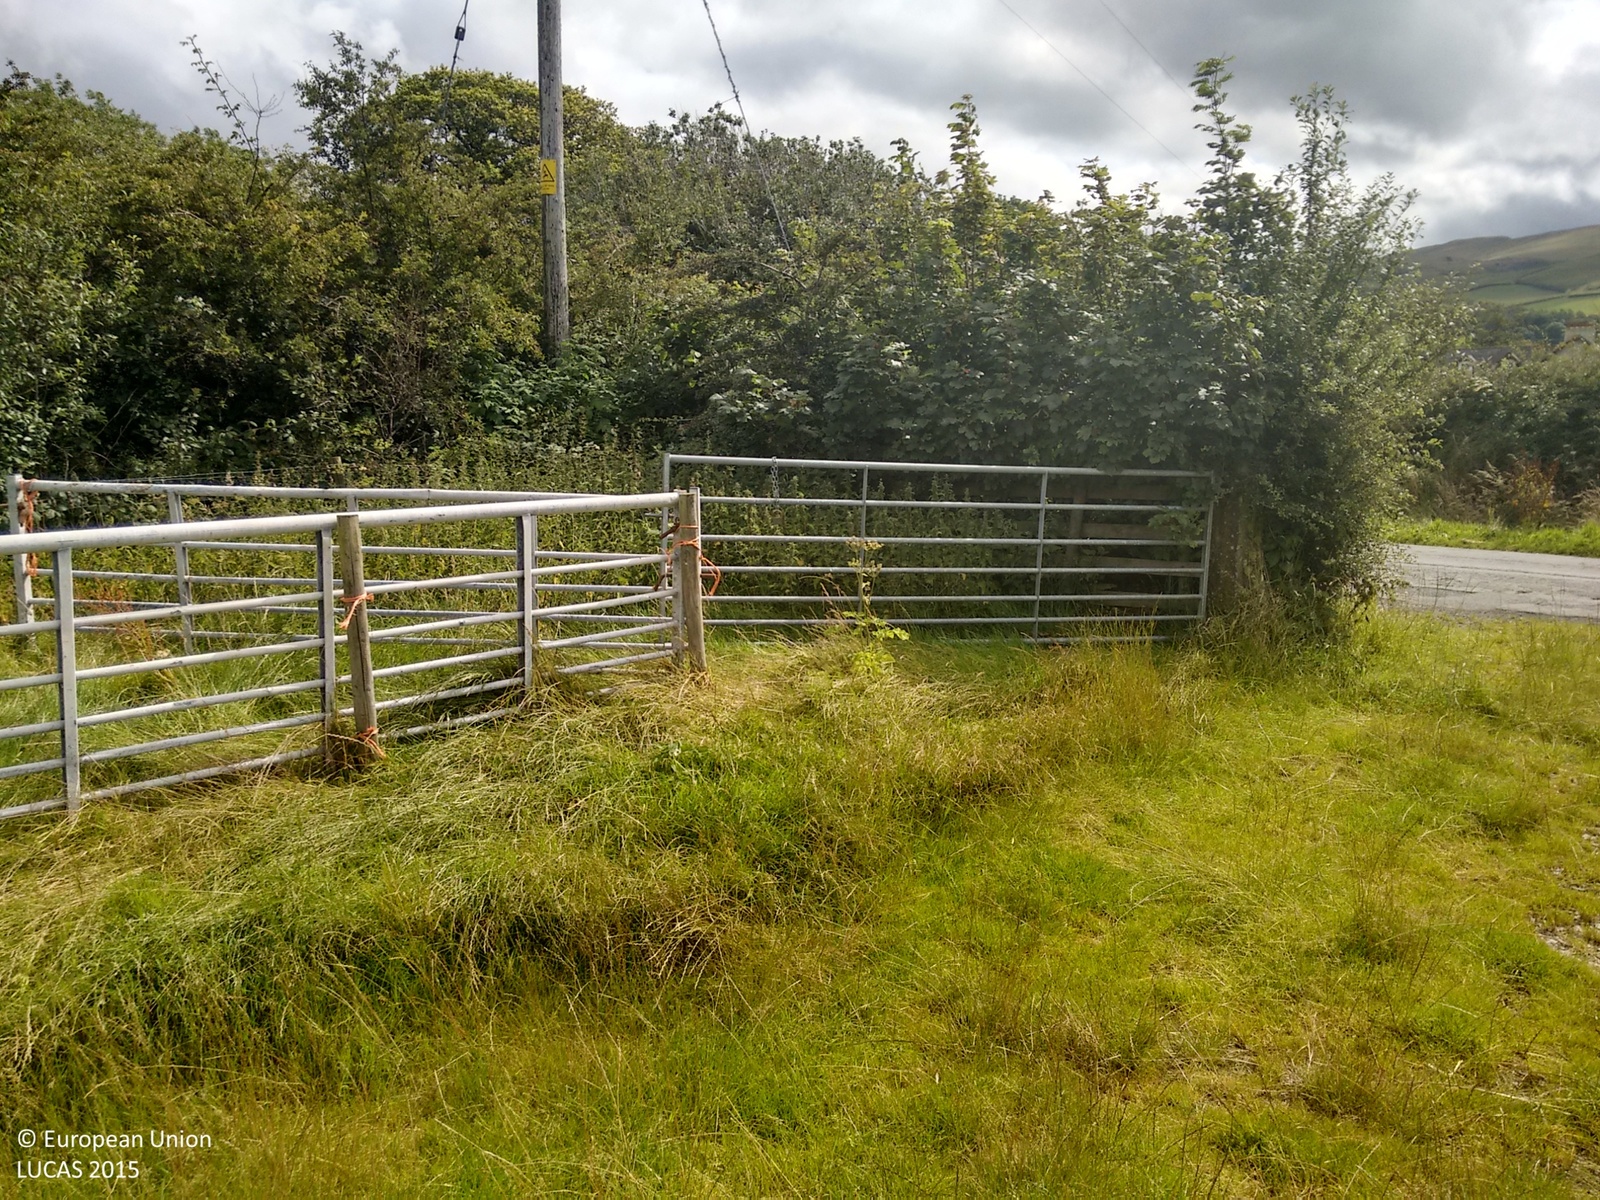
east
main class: Cropland
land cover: Oats
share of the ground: > 75 %
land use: Agriculture (excluding fallow land and kitchen gardens)
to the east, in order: Oats; Fences; Managed hedges; Electric lines; Temporary grasslands
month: August
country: GB
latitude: 54.6489
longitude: -3.3289
